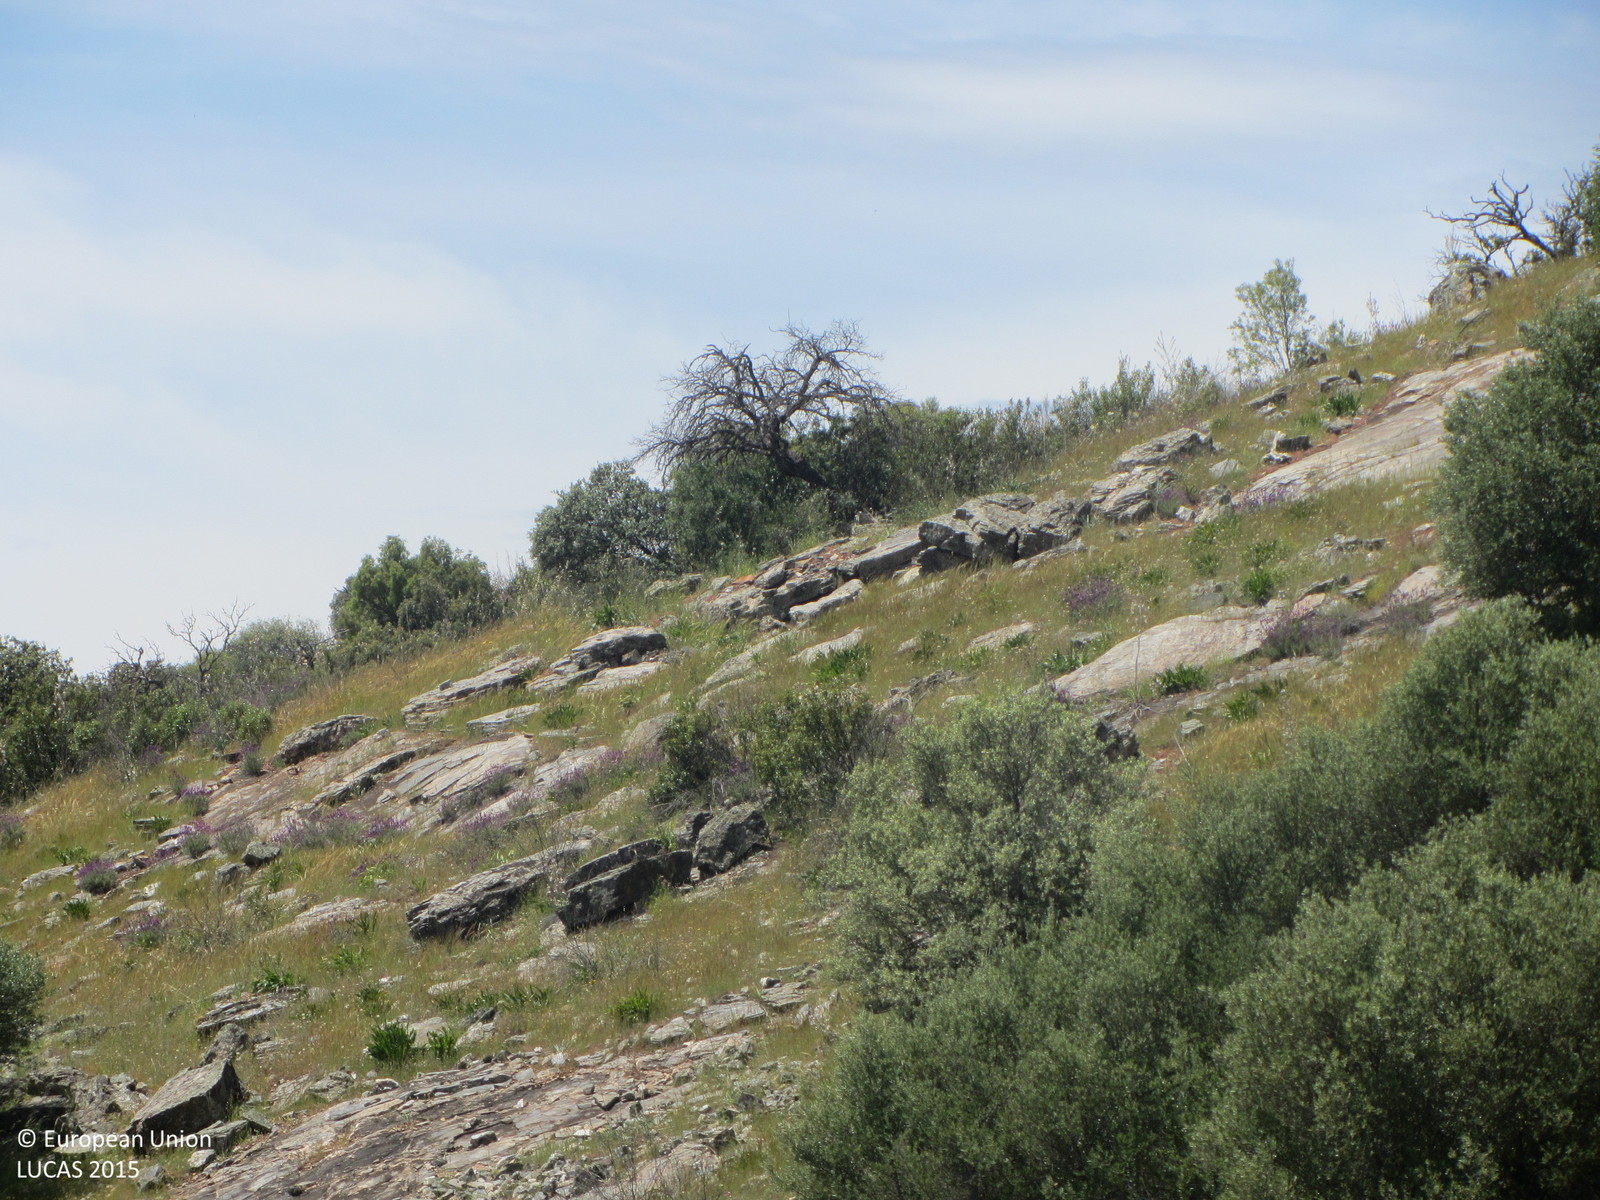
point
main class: Shrubland
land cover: Shrubland with sparse tree cover
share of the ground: 10 - 25 %
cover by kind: herbaceous plants 35 %, consolidated bare surface 35 %, shrubs 25 %, broadleaved forest trees 5 %
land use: Semi-natural and natural areas not in use
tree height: < 5 m
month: May
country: ES
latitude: 38.3350
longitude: -3.0088
